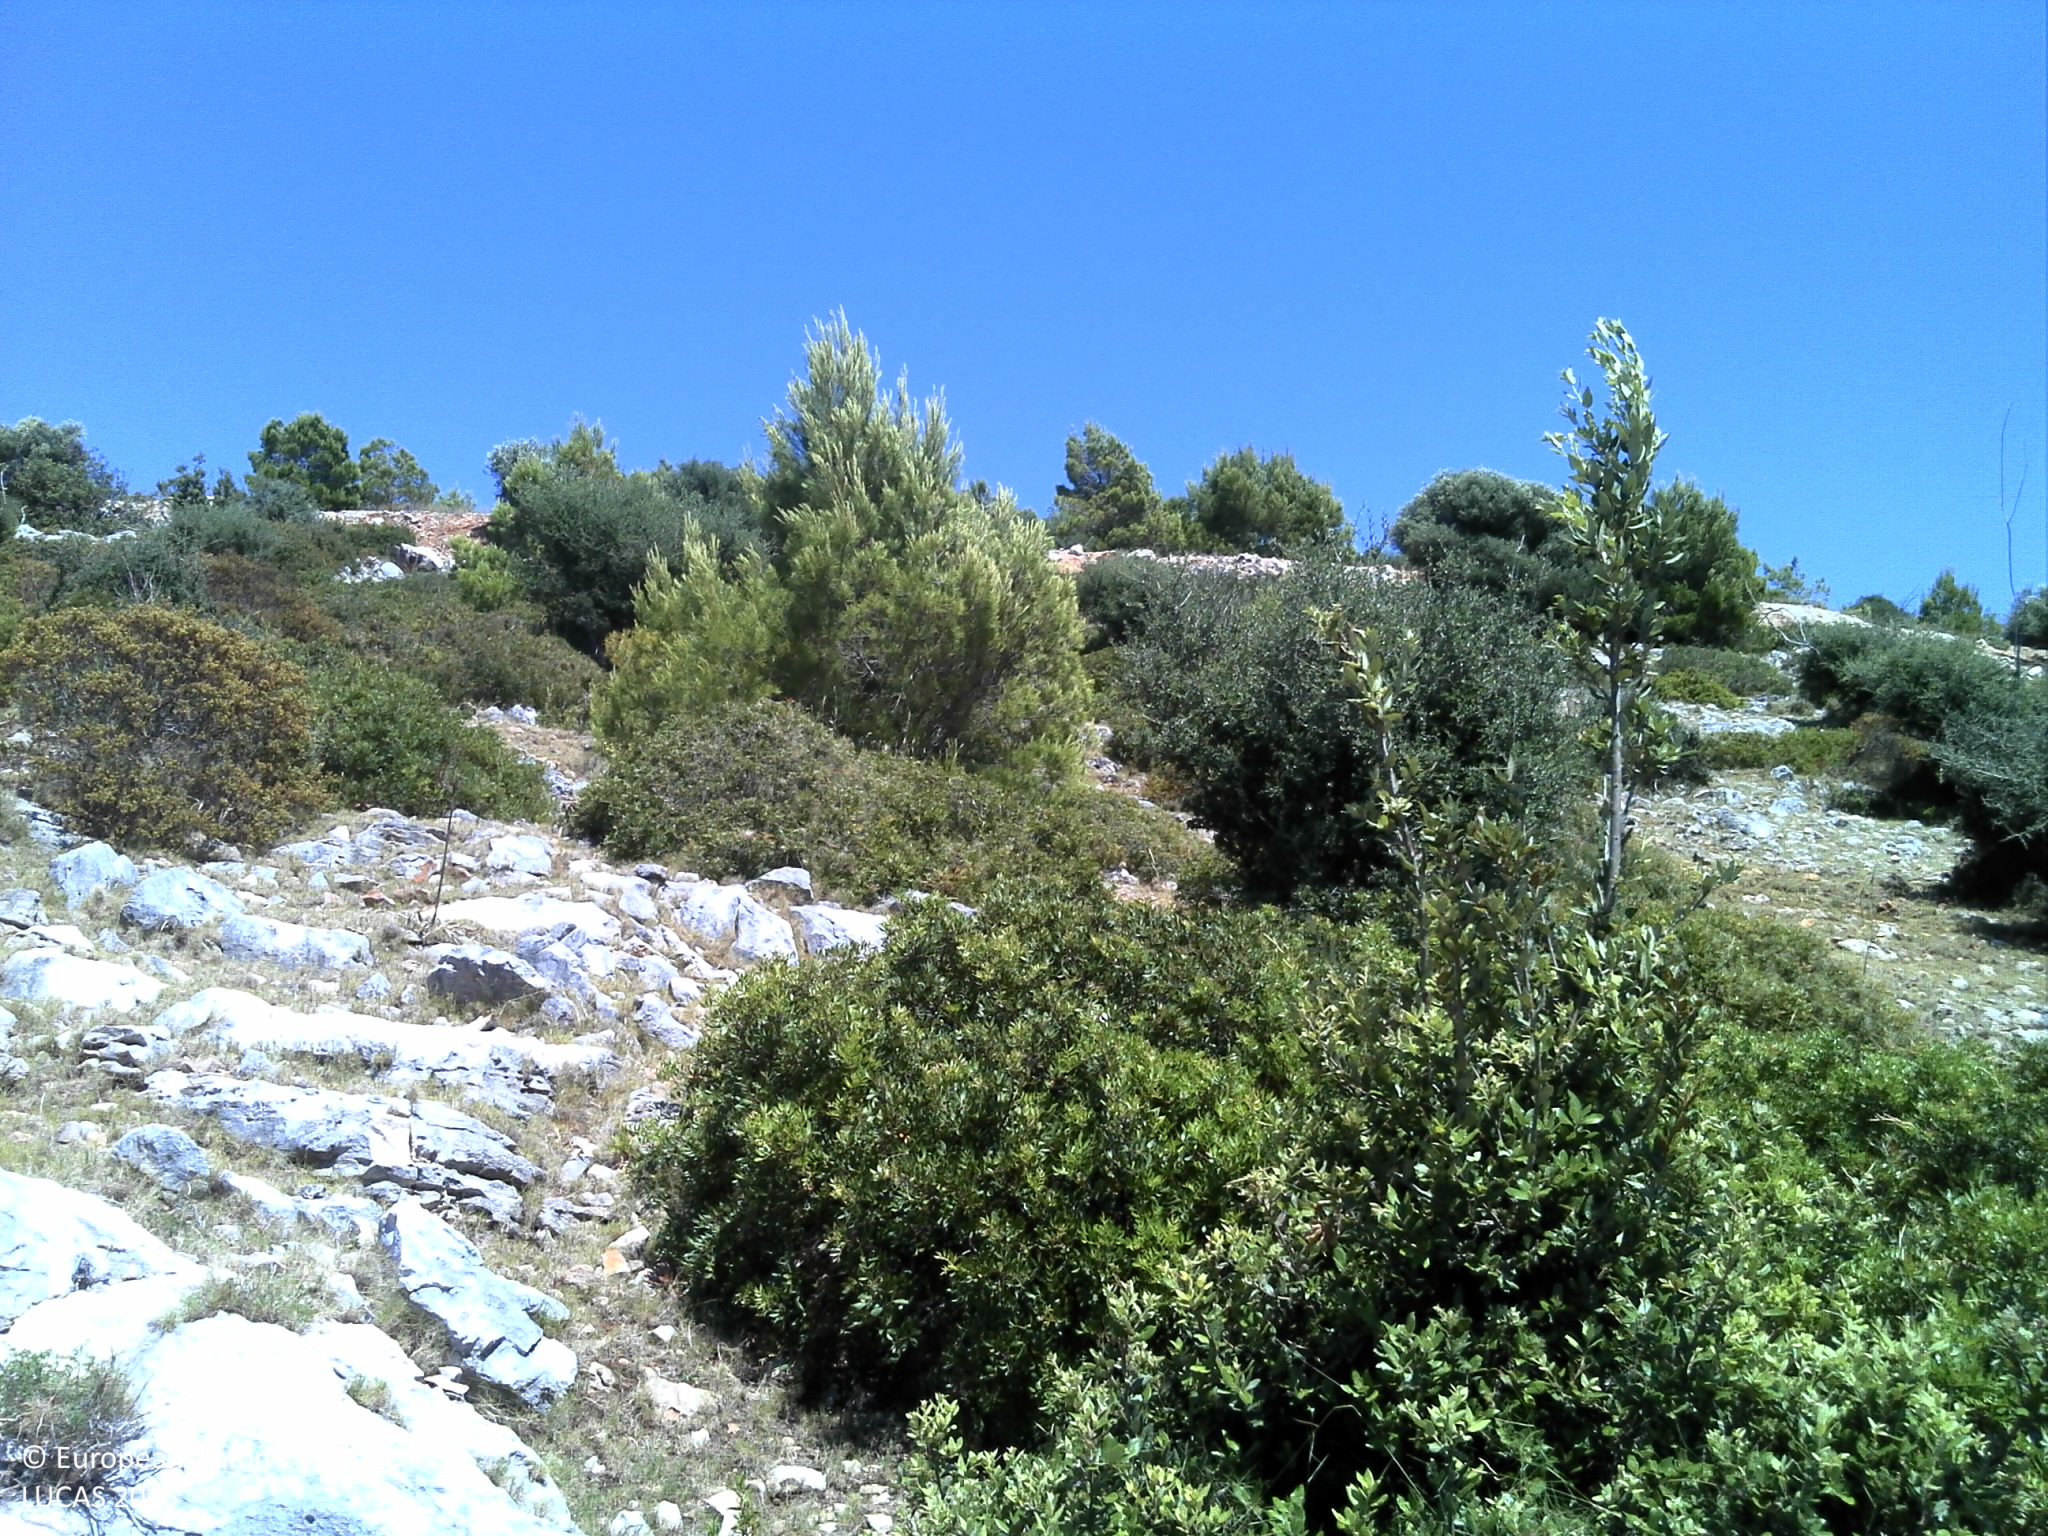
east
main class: Shrubland
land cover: Shrubland without tree cover
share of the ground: 50 - 75 %
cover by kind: shrubs 50 %, unconsolidated bare surface 25 %, consolidated bare surface 15 %, herbaceous plants 10 %
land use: Semi-natural and natural areas not in use
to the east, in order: Shrubland without tree cover; Paved roads, cycling and walking lanes; Shrubland without tree cover
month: June
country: HR
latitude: 42.7307
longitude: 16.8396
